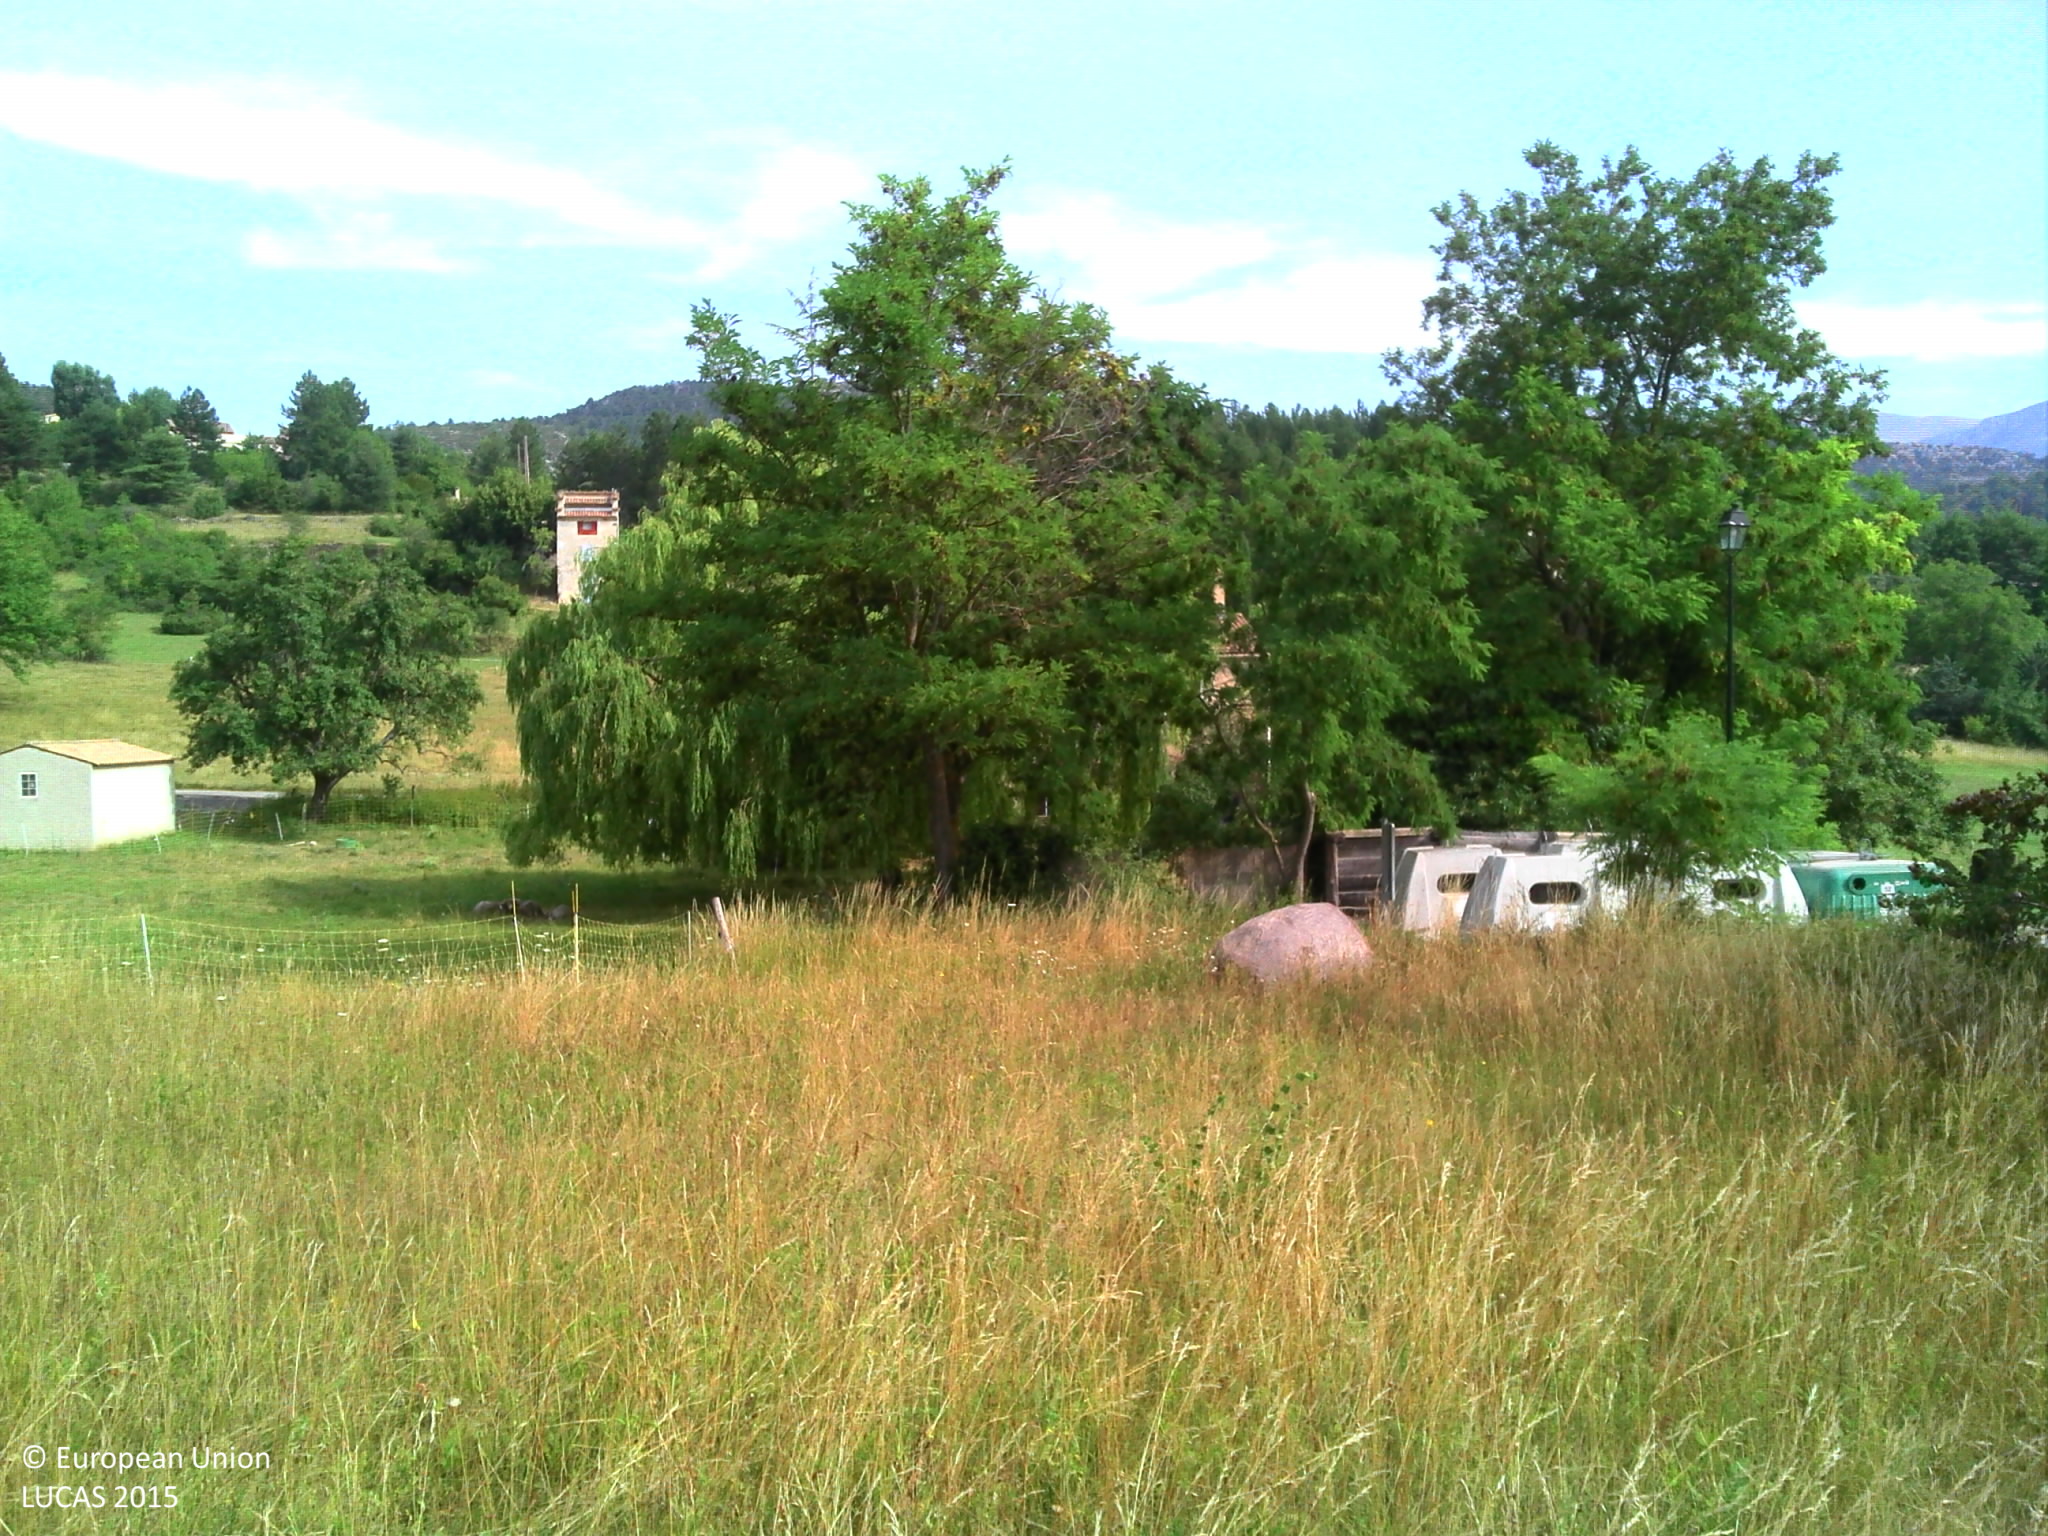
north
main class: Grassland
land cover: Grassland without tree/shrub cover
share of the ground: > 75 %
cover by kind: herbaceous plants 100 %
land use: Agriculture (excluding fallow land and kitchen gardens)
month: July
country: FR
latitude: 43.7805
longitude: 6.3427
